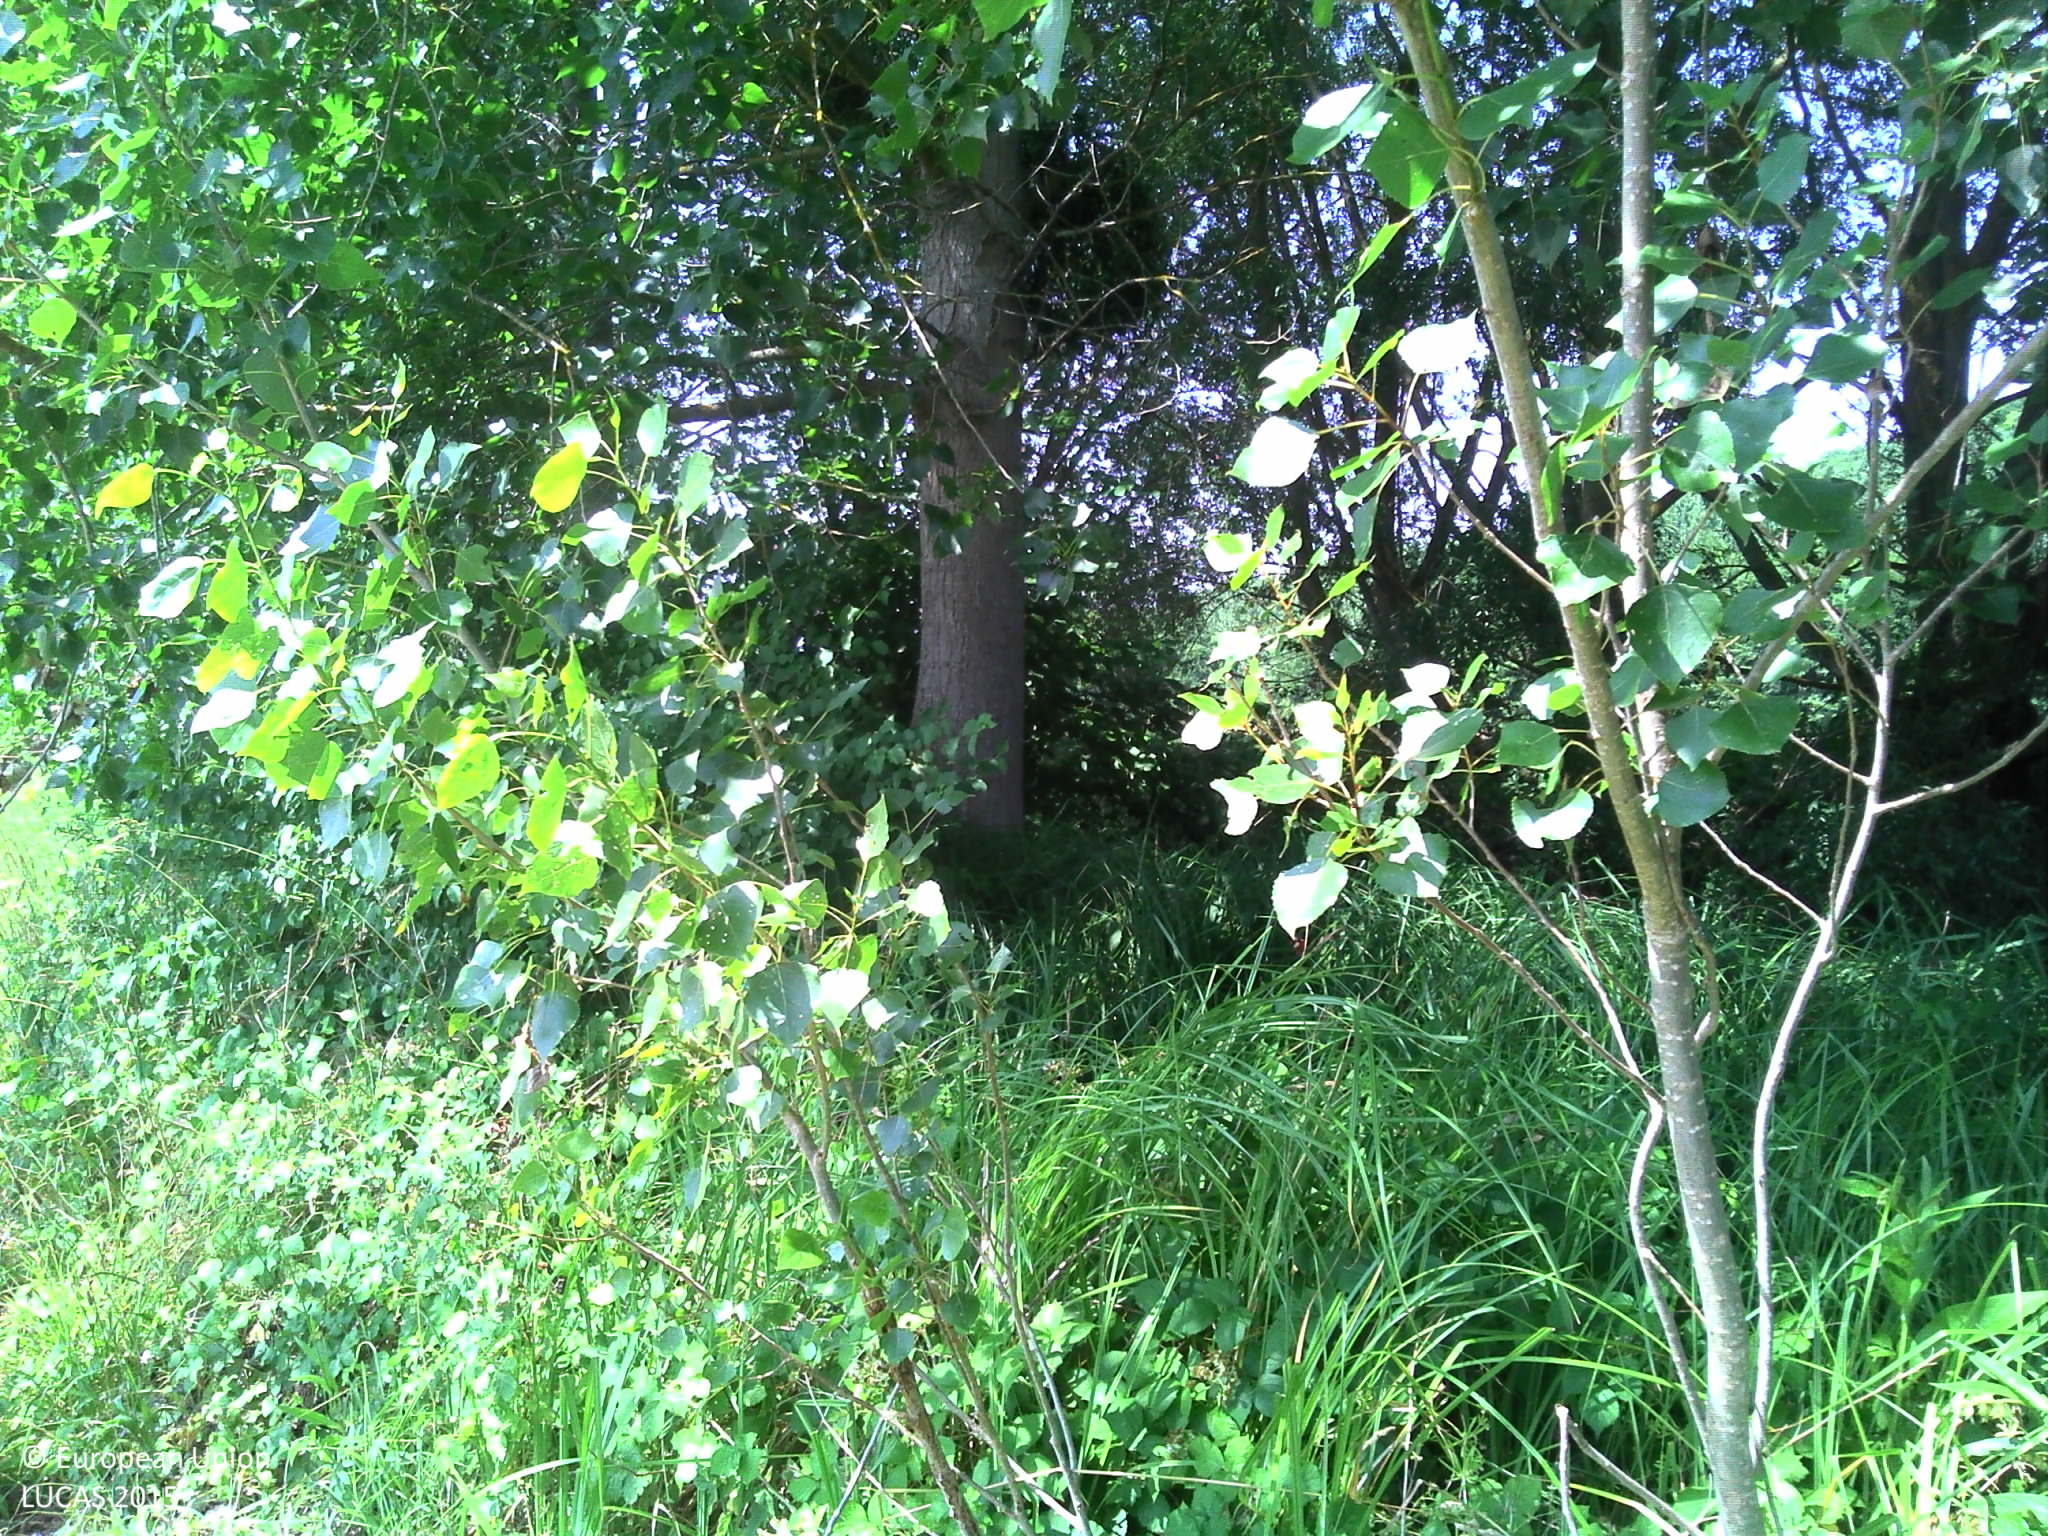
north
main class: Woodland
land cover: Broadleaved woodland
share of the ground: > 75 %
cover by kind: broadleaved forest trees 70 %, herbaceous plants 15 %, consolidated bare surface 15 %
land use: Semi-natural and natural areas not in use
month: July
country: FR
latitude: 48.8068
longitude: 1.3625
